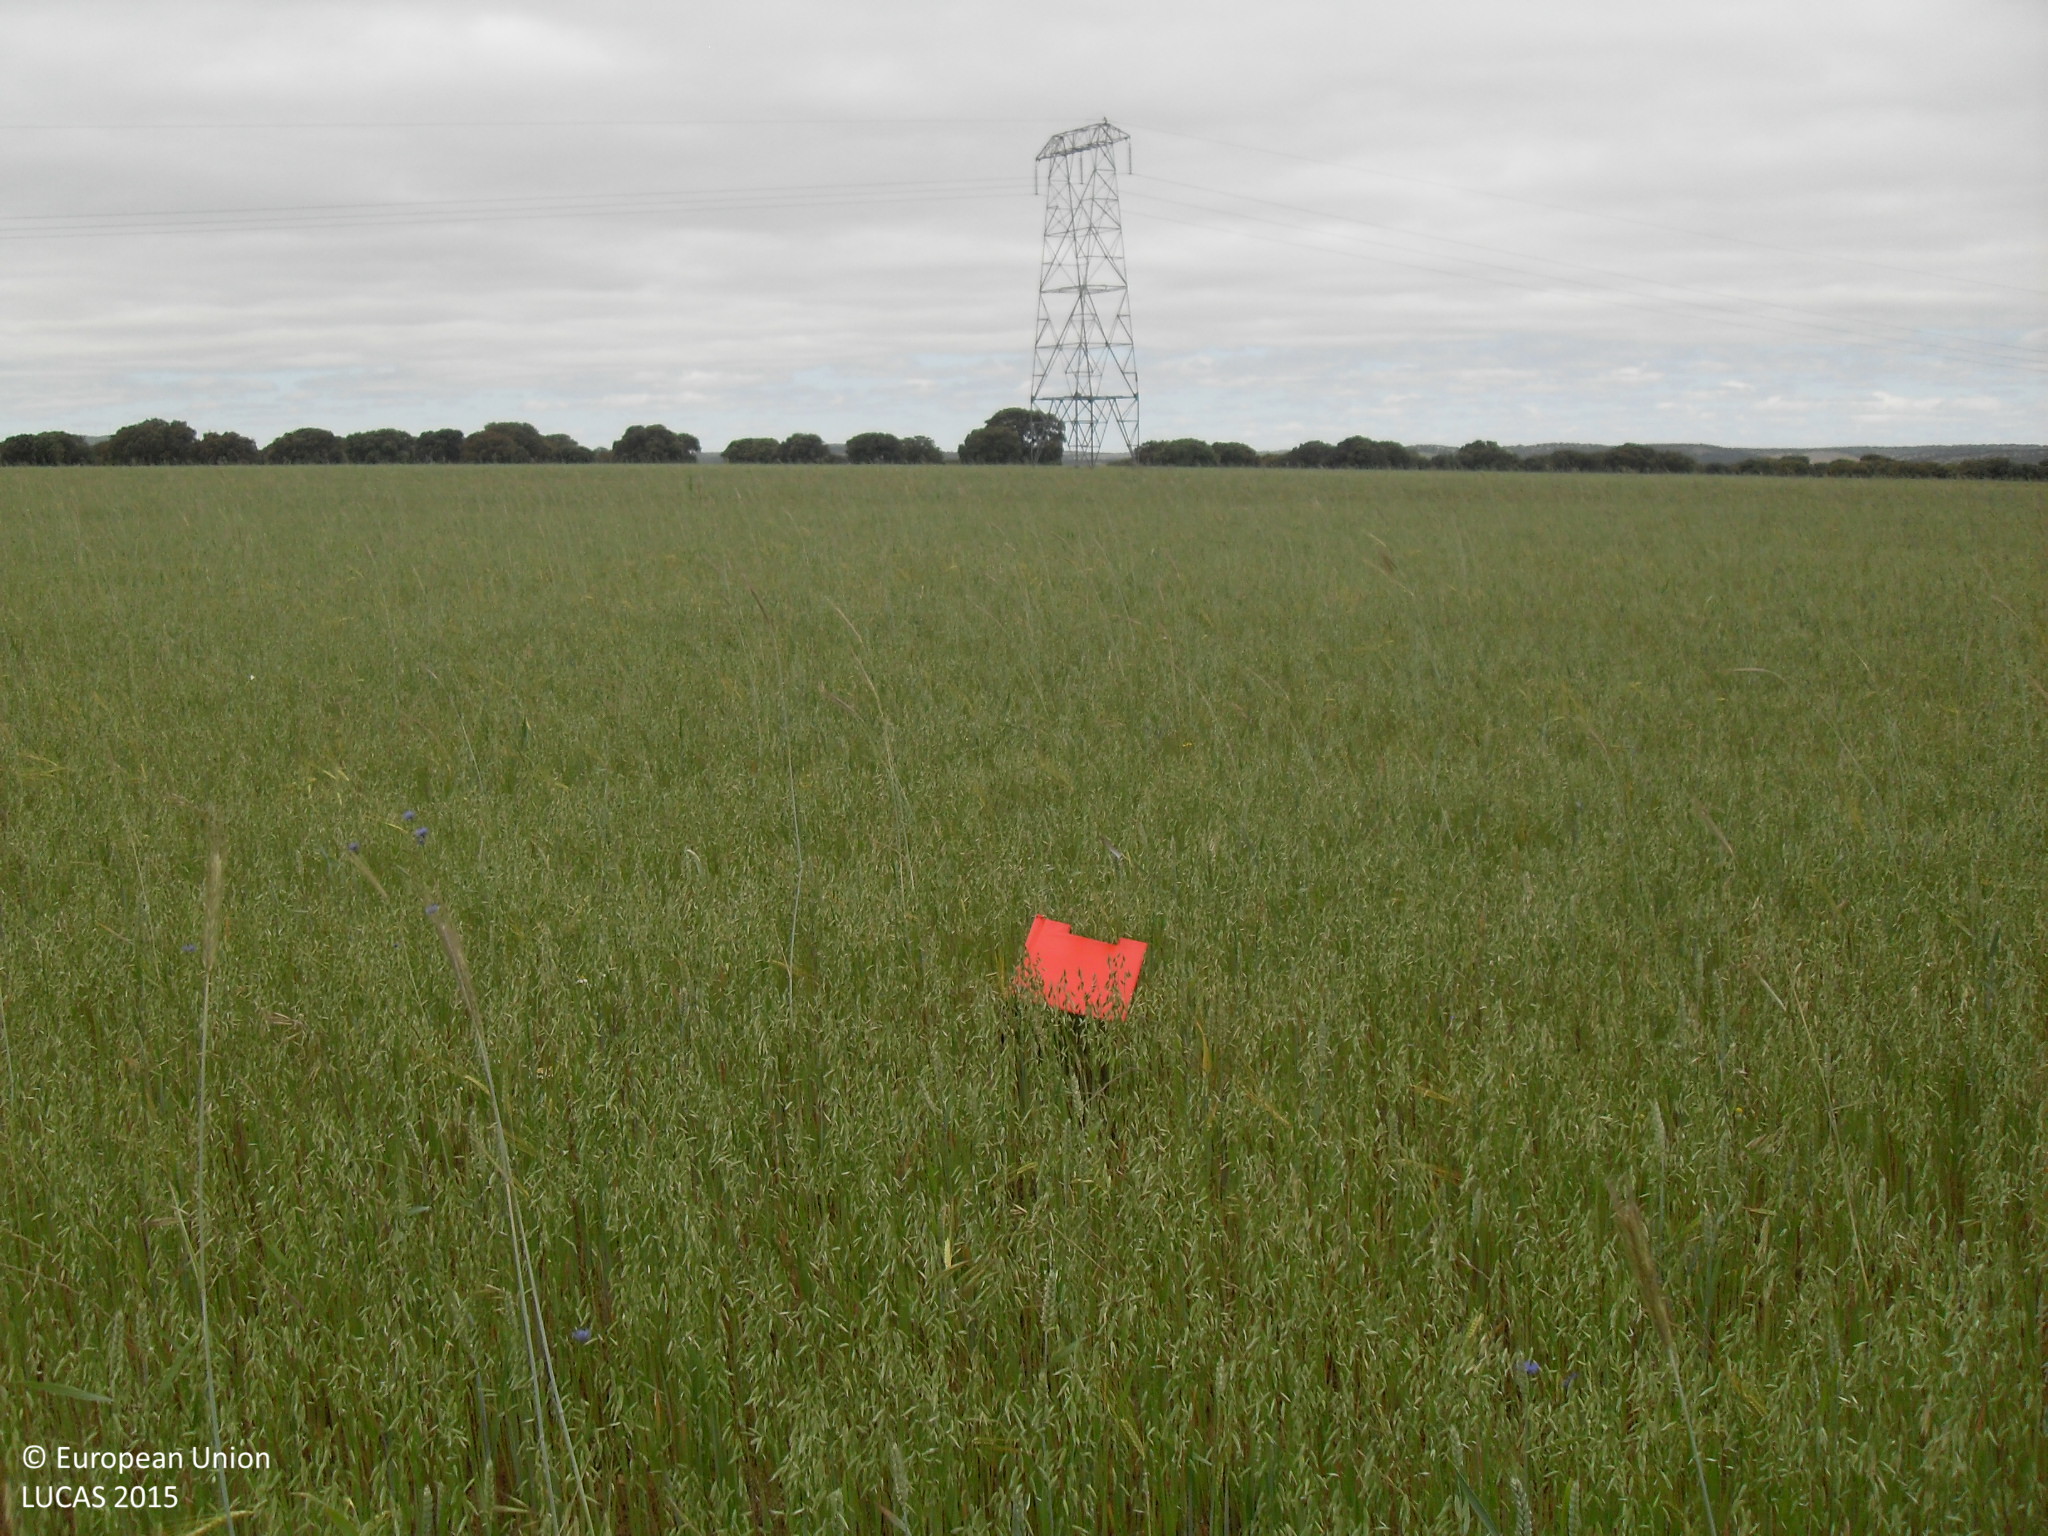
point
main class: Cropland
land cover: Oats
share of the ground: > 75 %
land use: Agriculture (excluding fallow land and kitchen gardens)
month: May
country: ES
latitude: 40.6610
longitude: -5.6260
